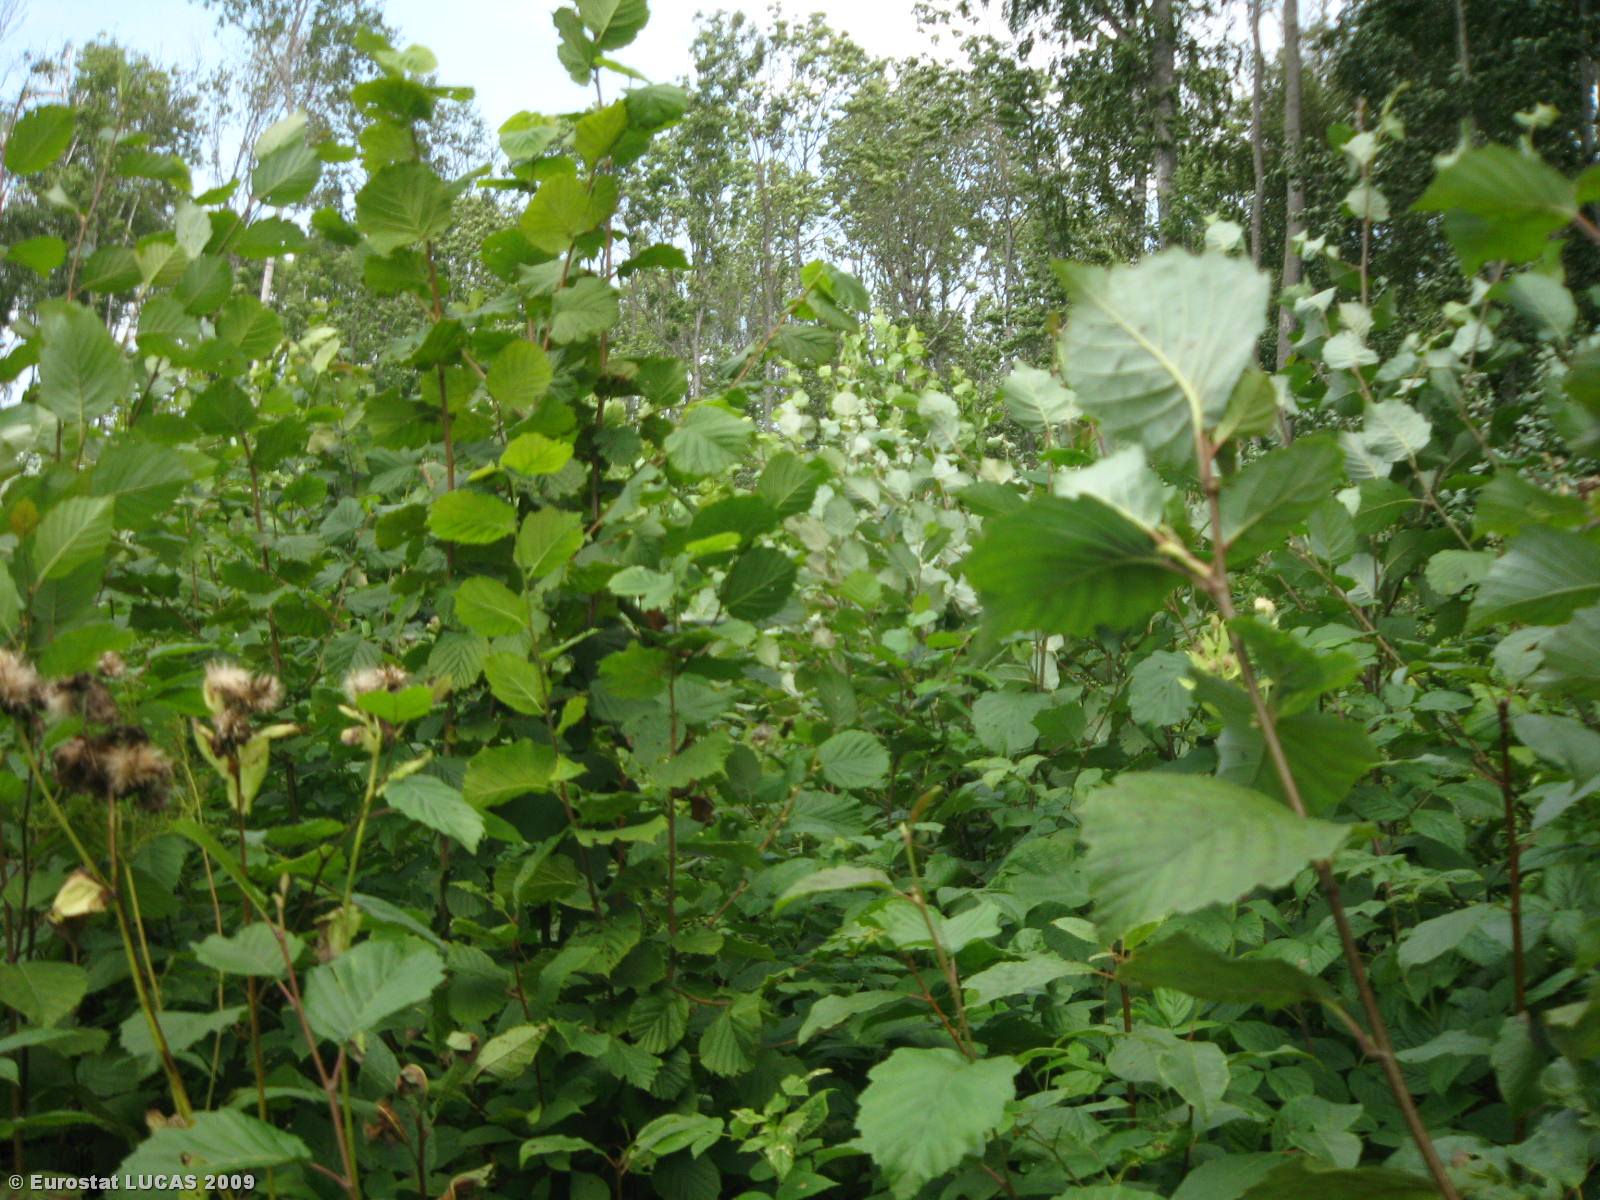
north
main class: Woodland
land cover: Broadleaved woodland
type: mesophytic deciduous forest
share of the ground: > 75 %
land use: Forestry
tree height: > 5 m
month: August
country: LT
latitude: 56.2402
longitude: 24.1429
